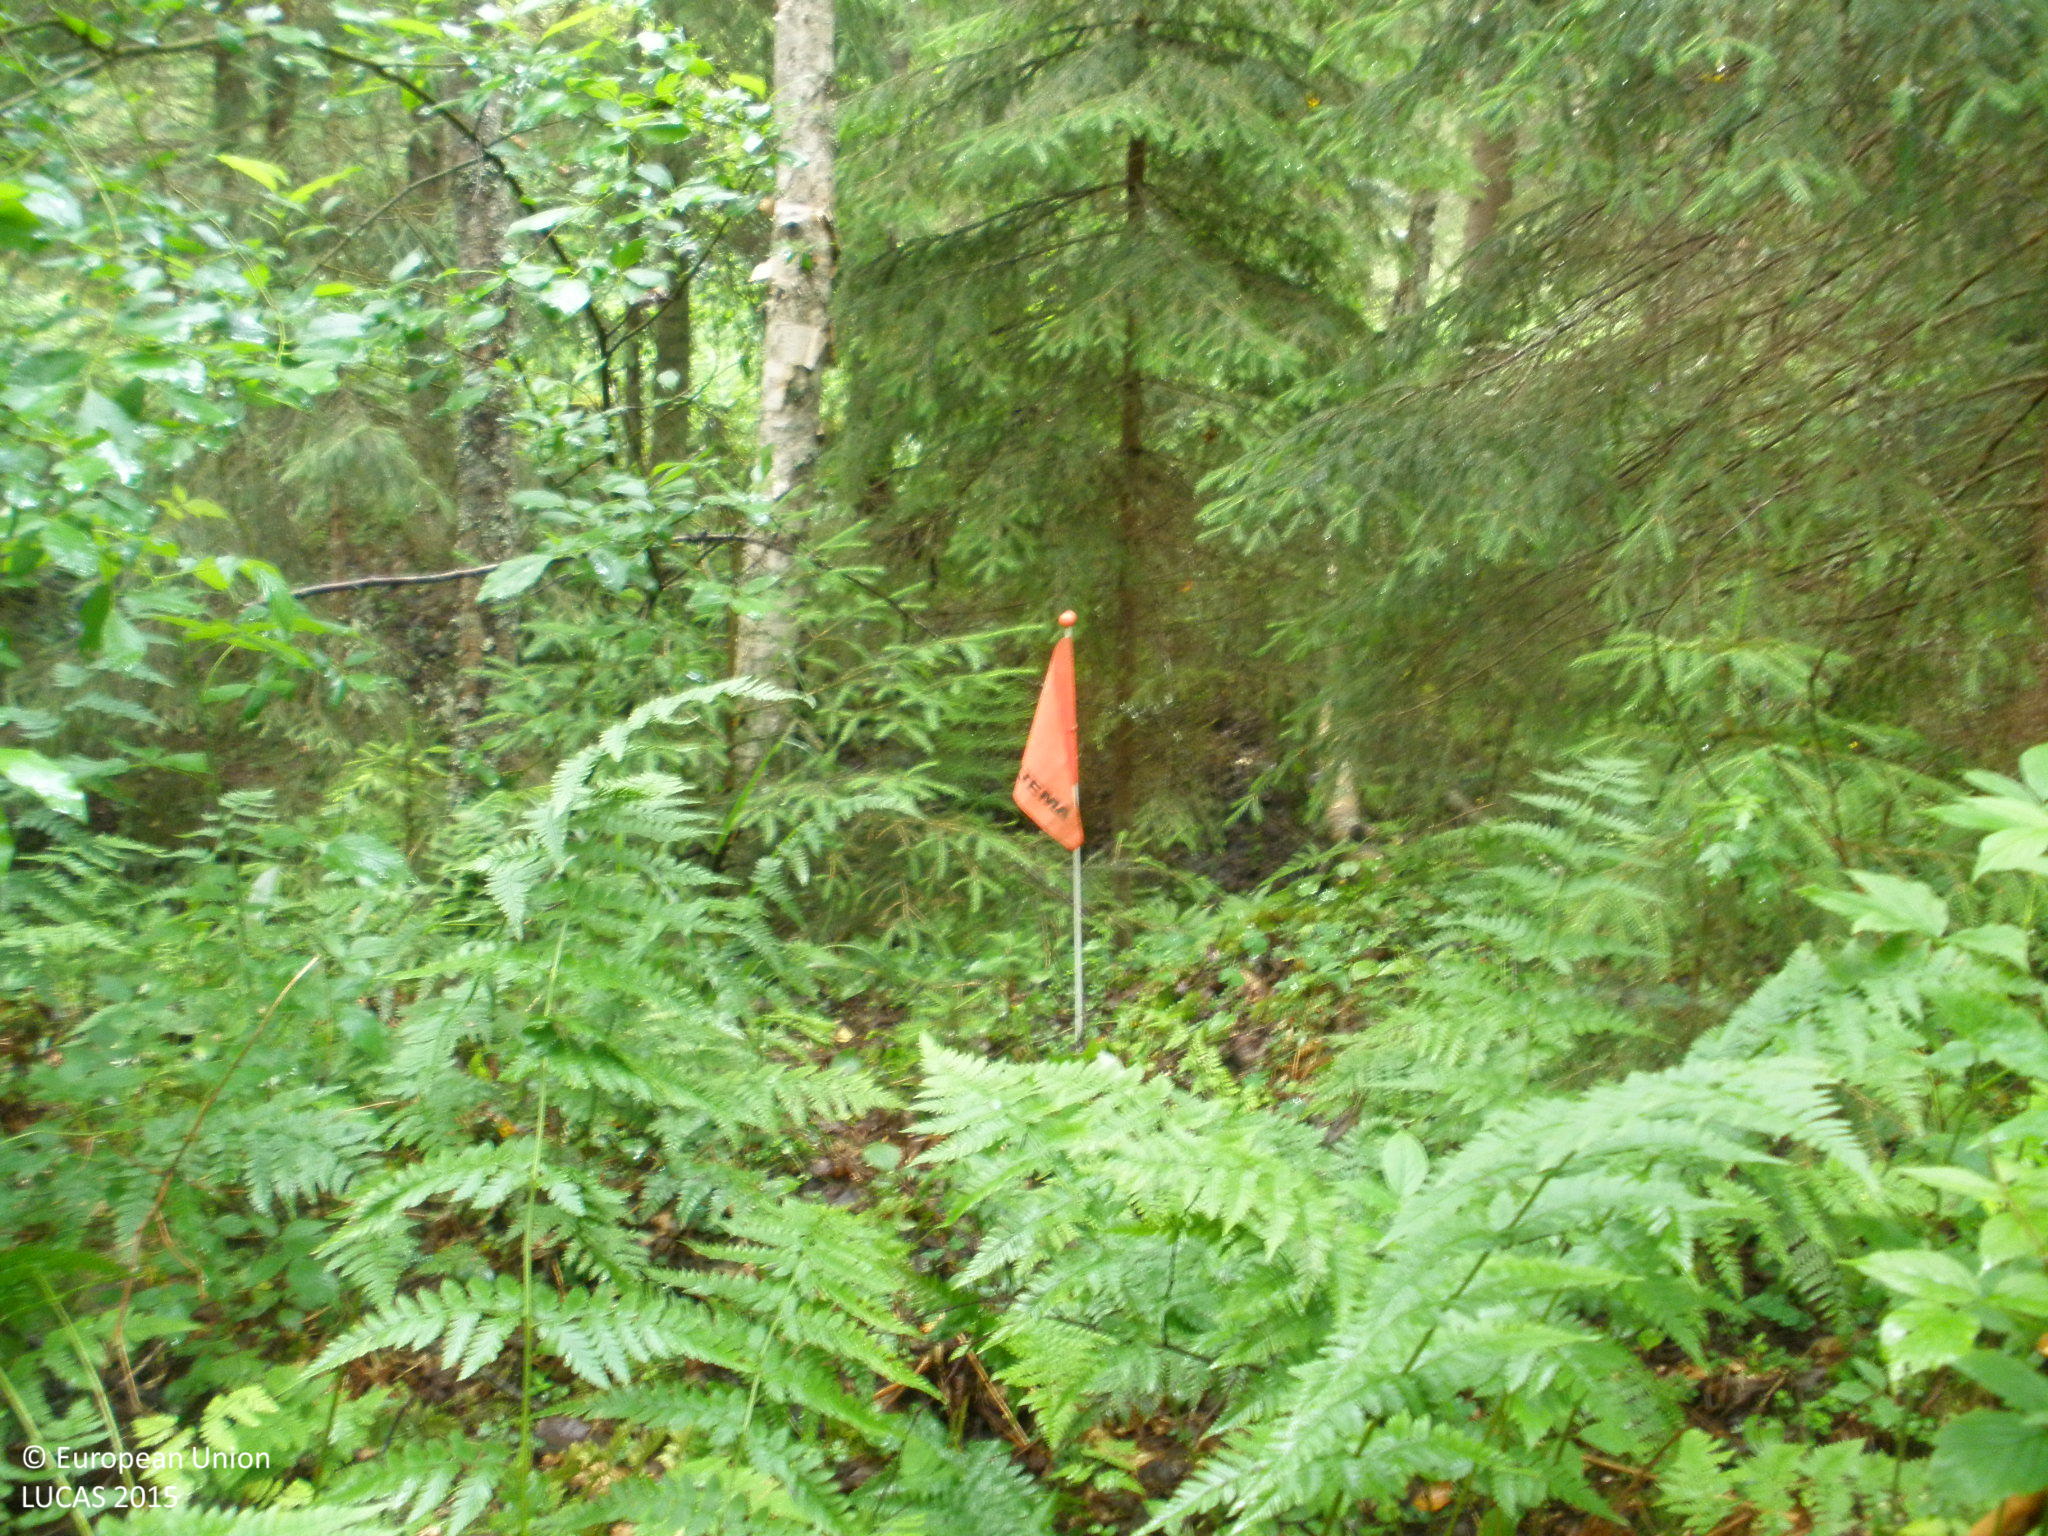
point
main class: Woodland
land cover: Spruce dominated mixed woodland
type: boreal forest
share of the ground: > 75 %
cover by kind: coniferous forest trees 40 %, broadleaved forest trees 40 %, herbaceous plants 10 %, lichens and mosses 10 %
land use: Forestry
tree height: > 5 m
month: July
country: FI
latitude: 61.0191
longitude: 24.8940
